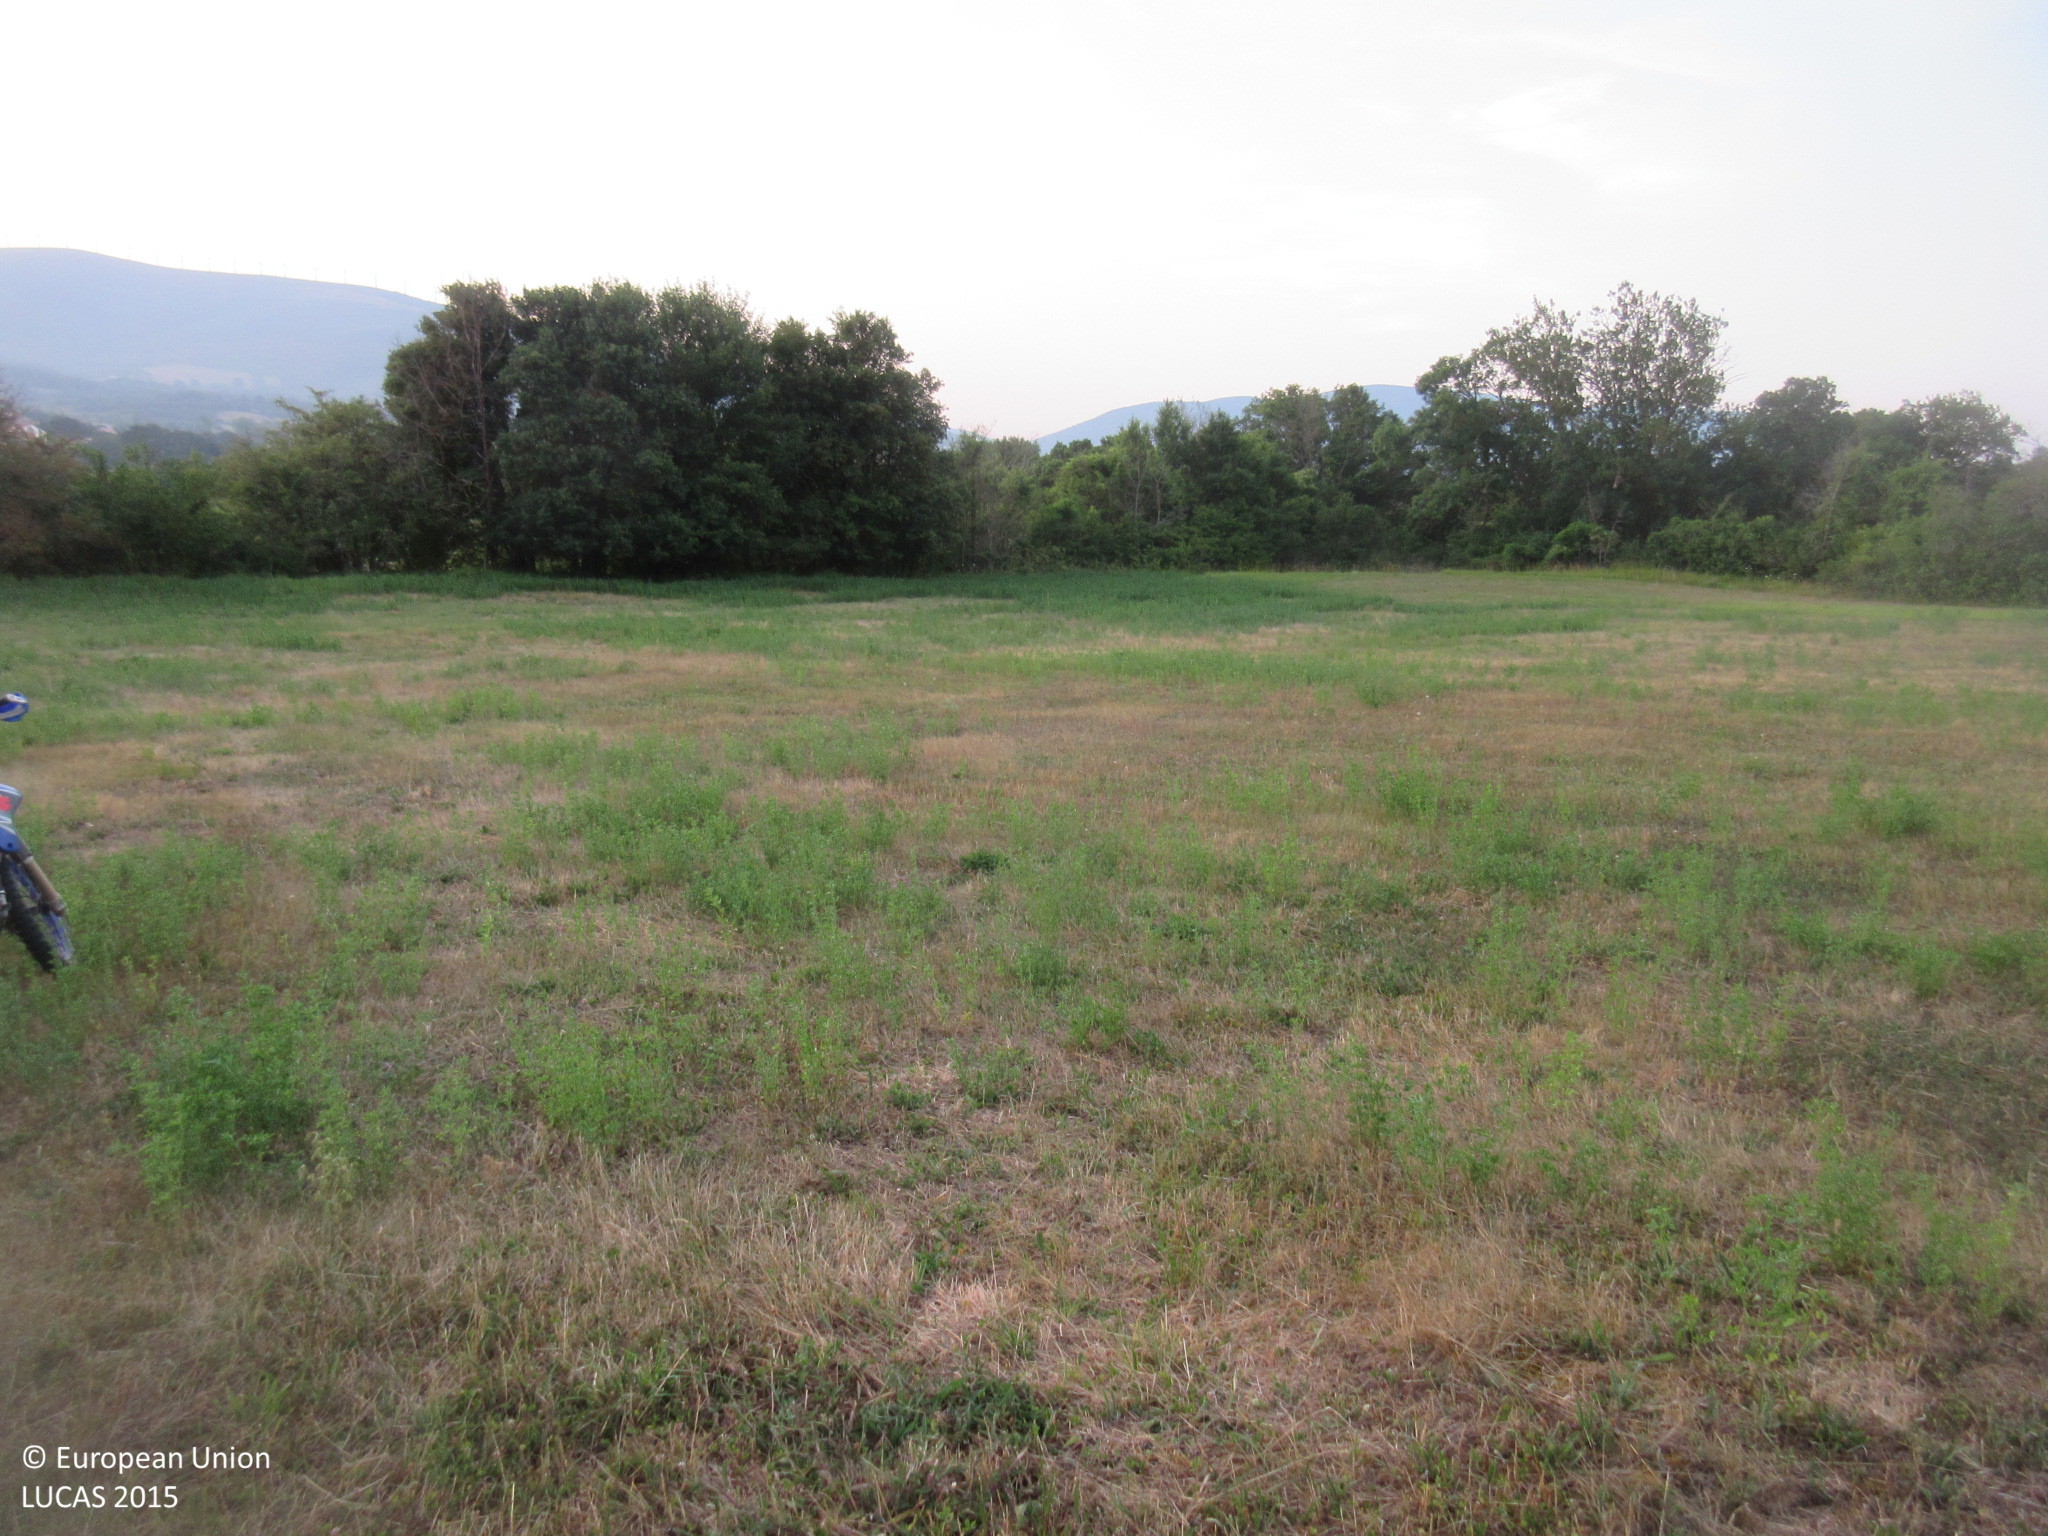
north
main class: Cropland
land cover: Lucerne
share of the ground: 25 - 50 %
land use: Agriculture (excluding fallow land and kitchen gardens)
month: July
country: ES
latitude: 43.0668
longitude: -3.4620
